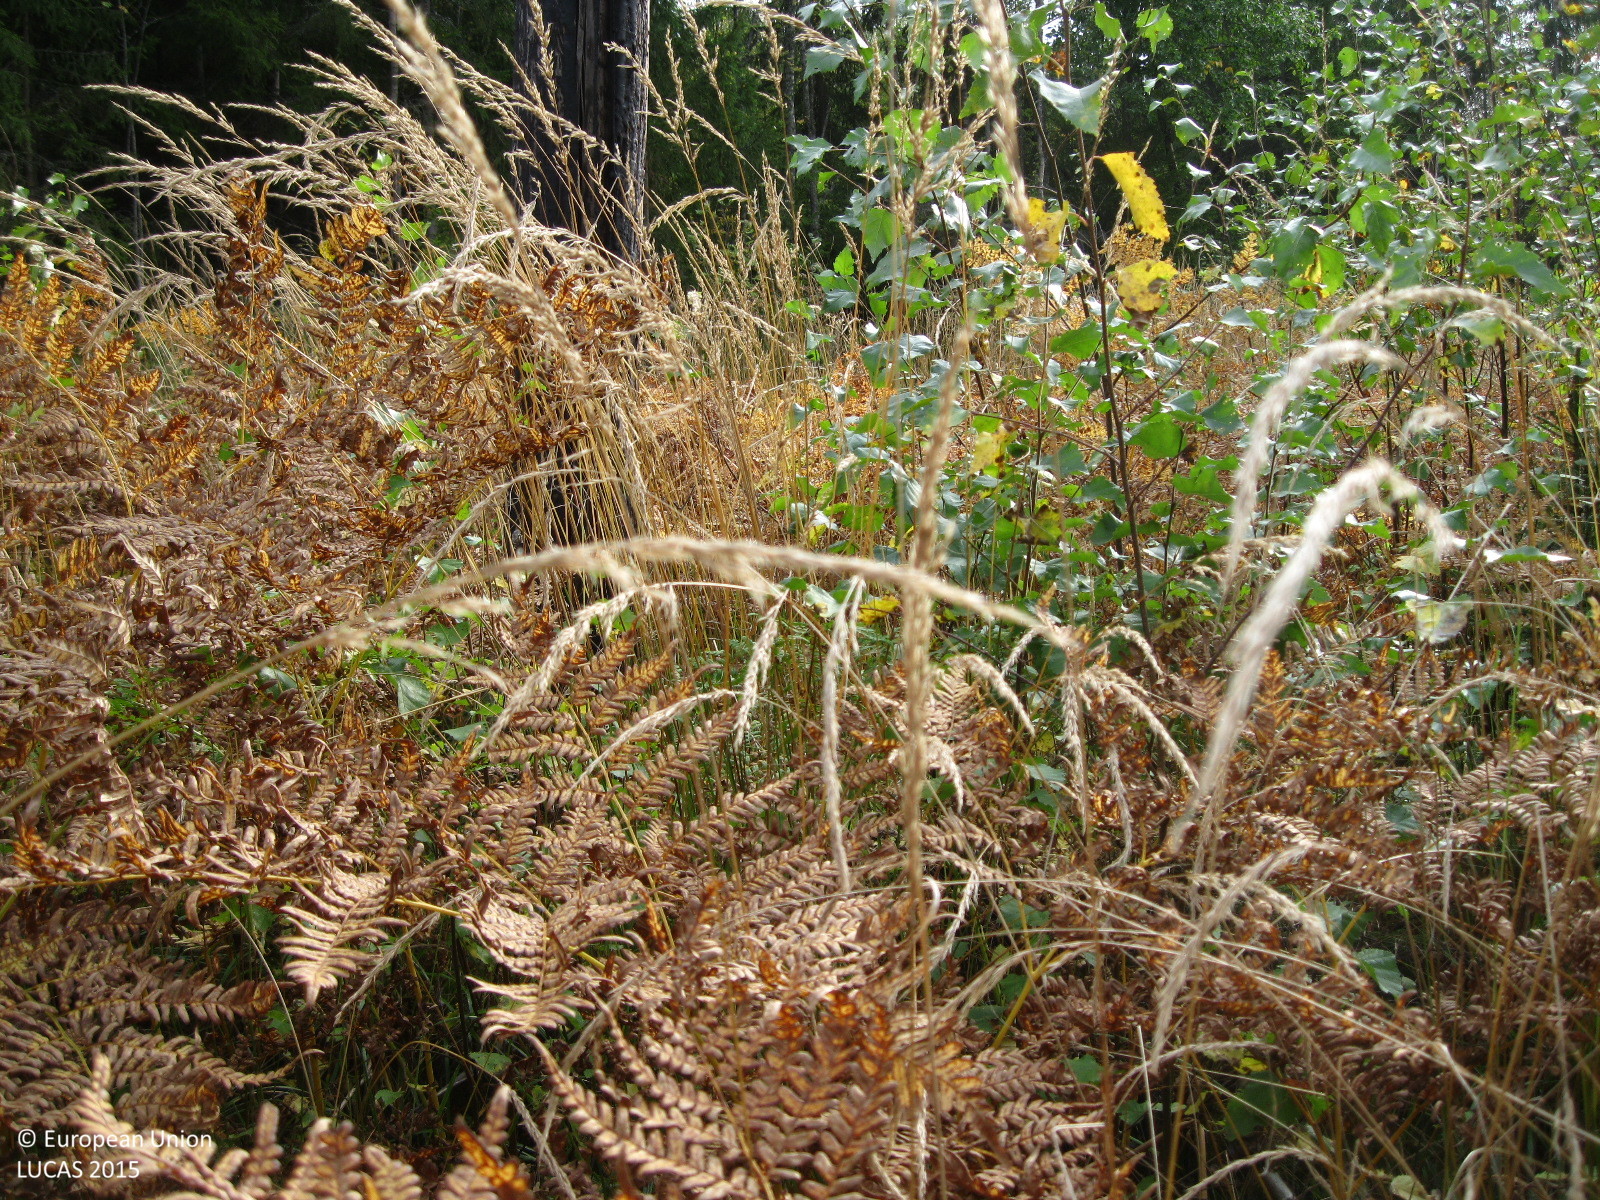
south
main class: Woodland
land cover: Broadleaved woodland
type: boreal forest
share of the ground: 25 - 50 %
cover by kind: herbaceous plants 60 %, broadleaved forest trees 40 %
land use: Electricity, gas and thermal power distribution
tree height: < 5 m
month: September
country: FI
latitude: 60.7134
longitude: 24.8277
